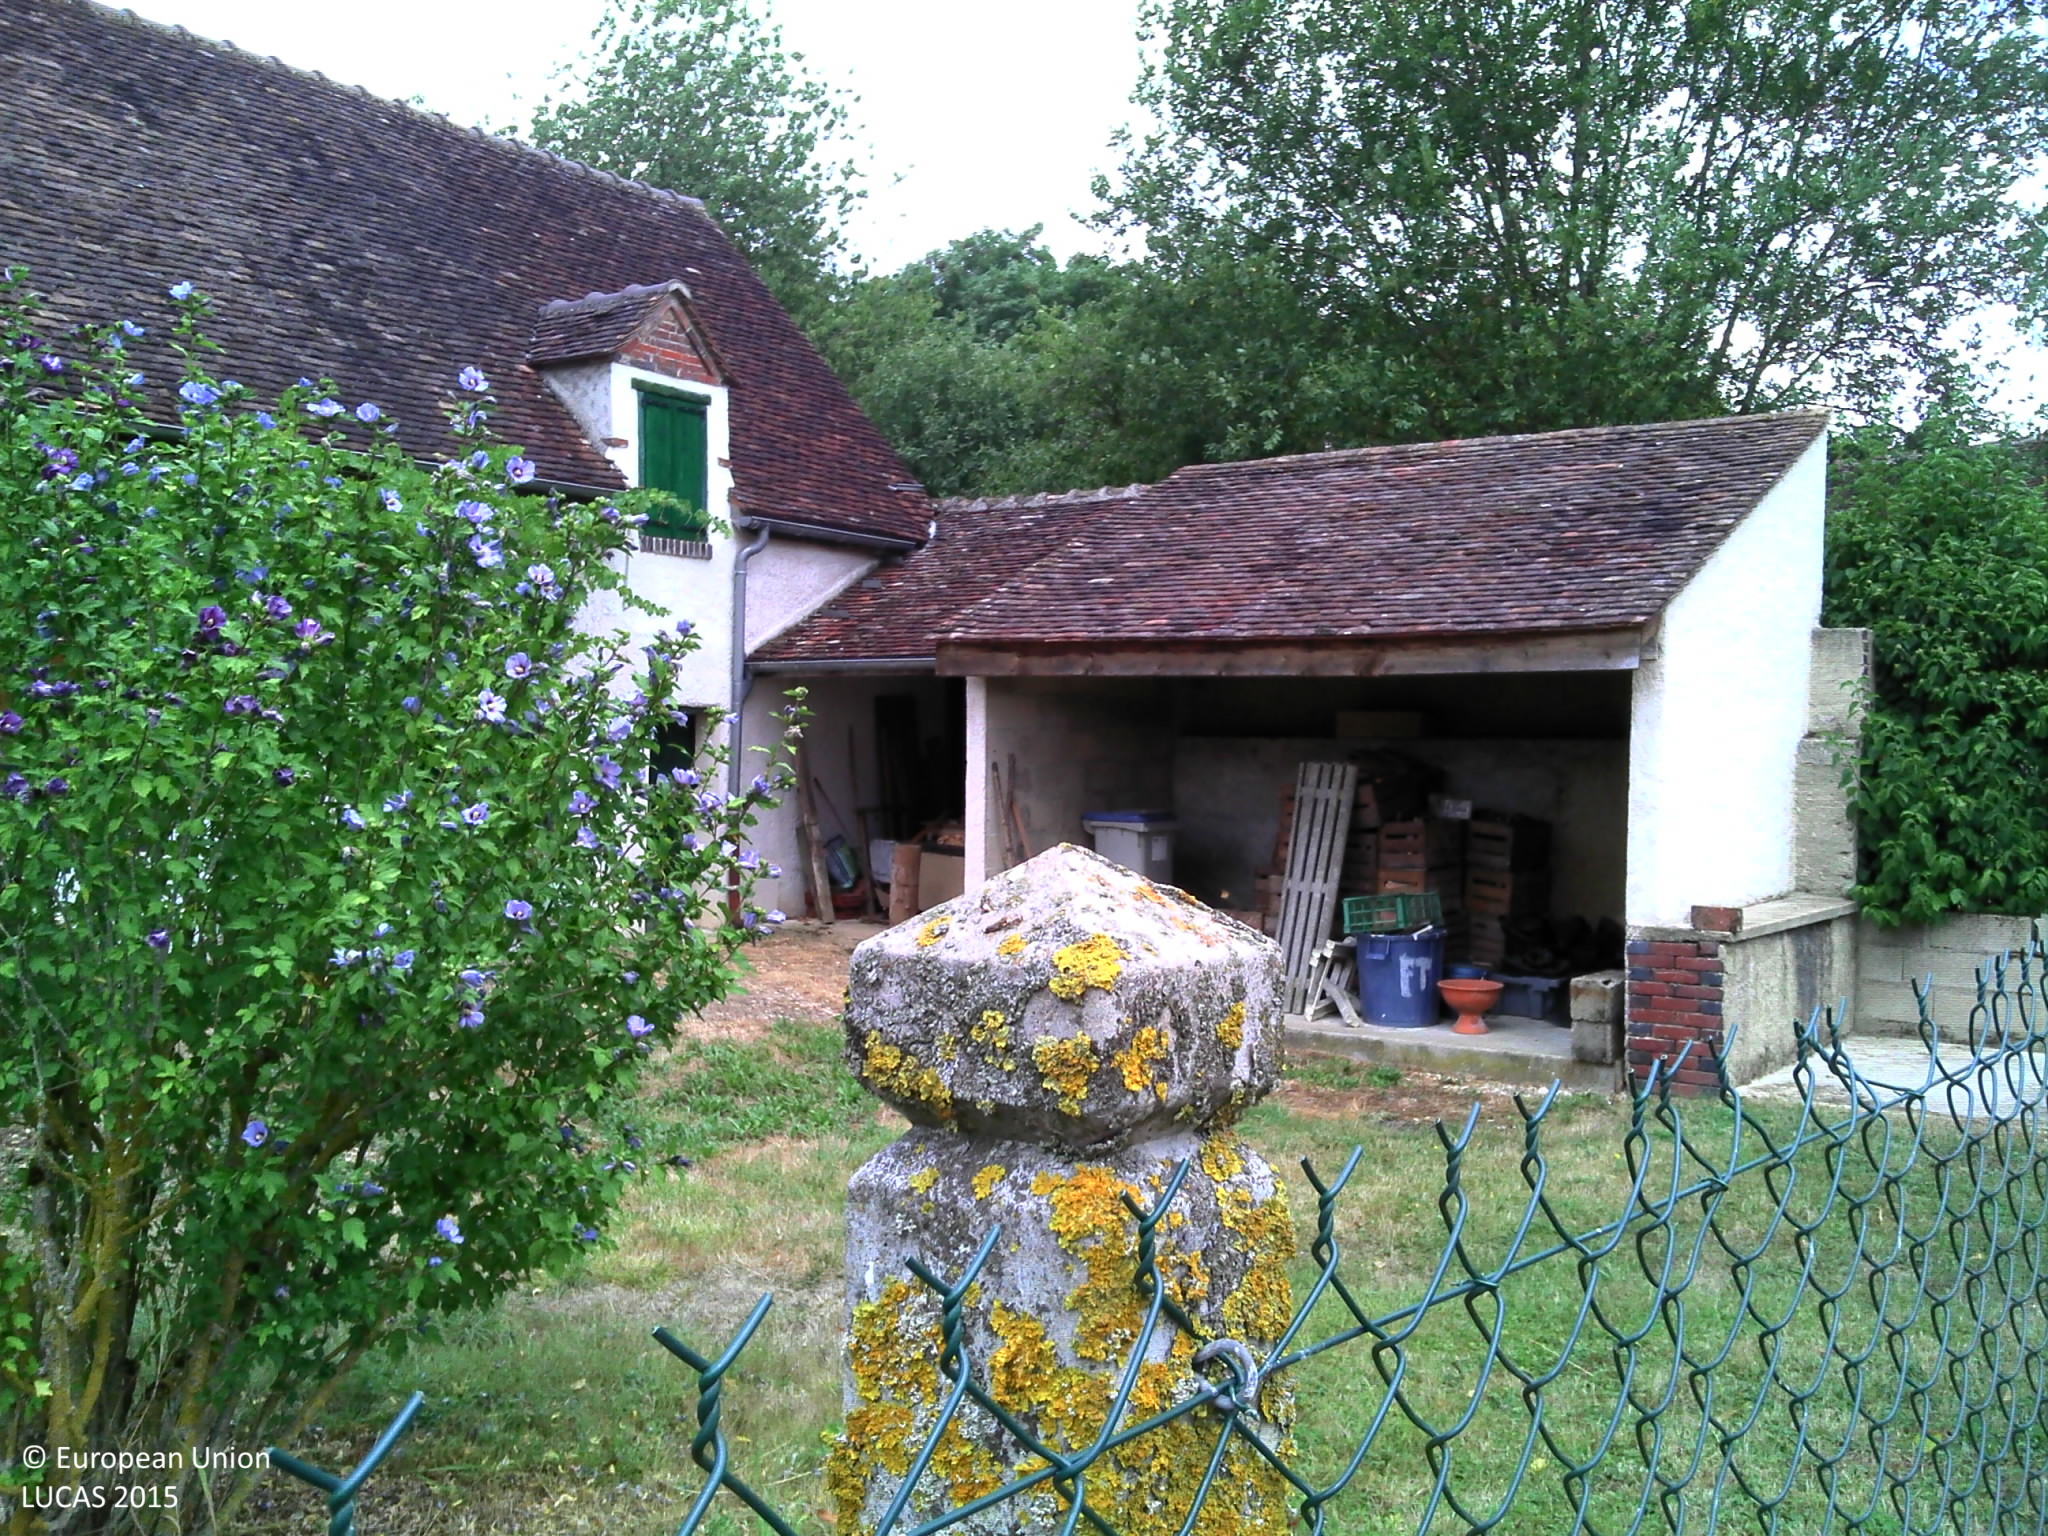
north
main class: Grassland
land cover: Grassland with sparse tree/shrub cover
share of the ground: > 75 %
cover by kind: herbaceous plants 90 %, broadleaved forest trees 5 %, shrubs 5 %
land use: Amenities, museums, leisure
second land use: Residential
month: July
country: FR
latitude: 48.0801
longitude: 3.4036
